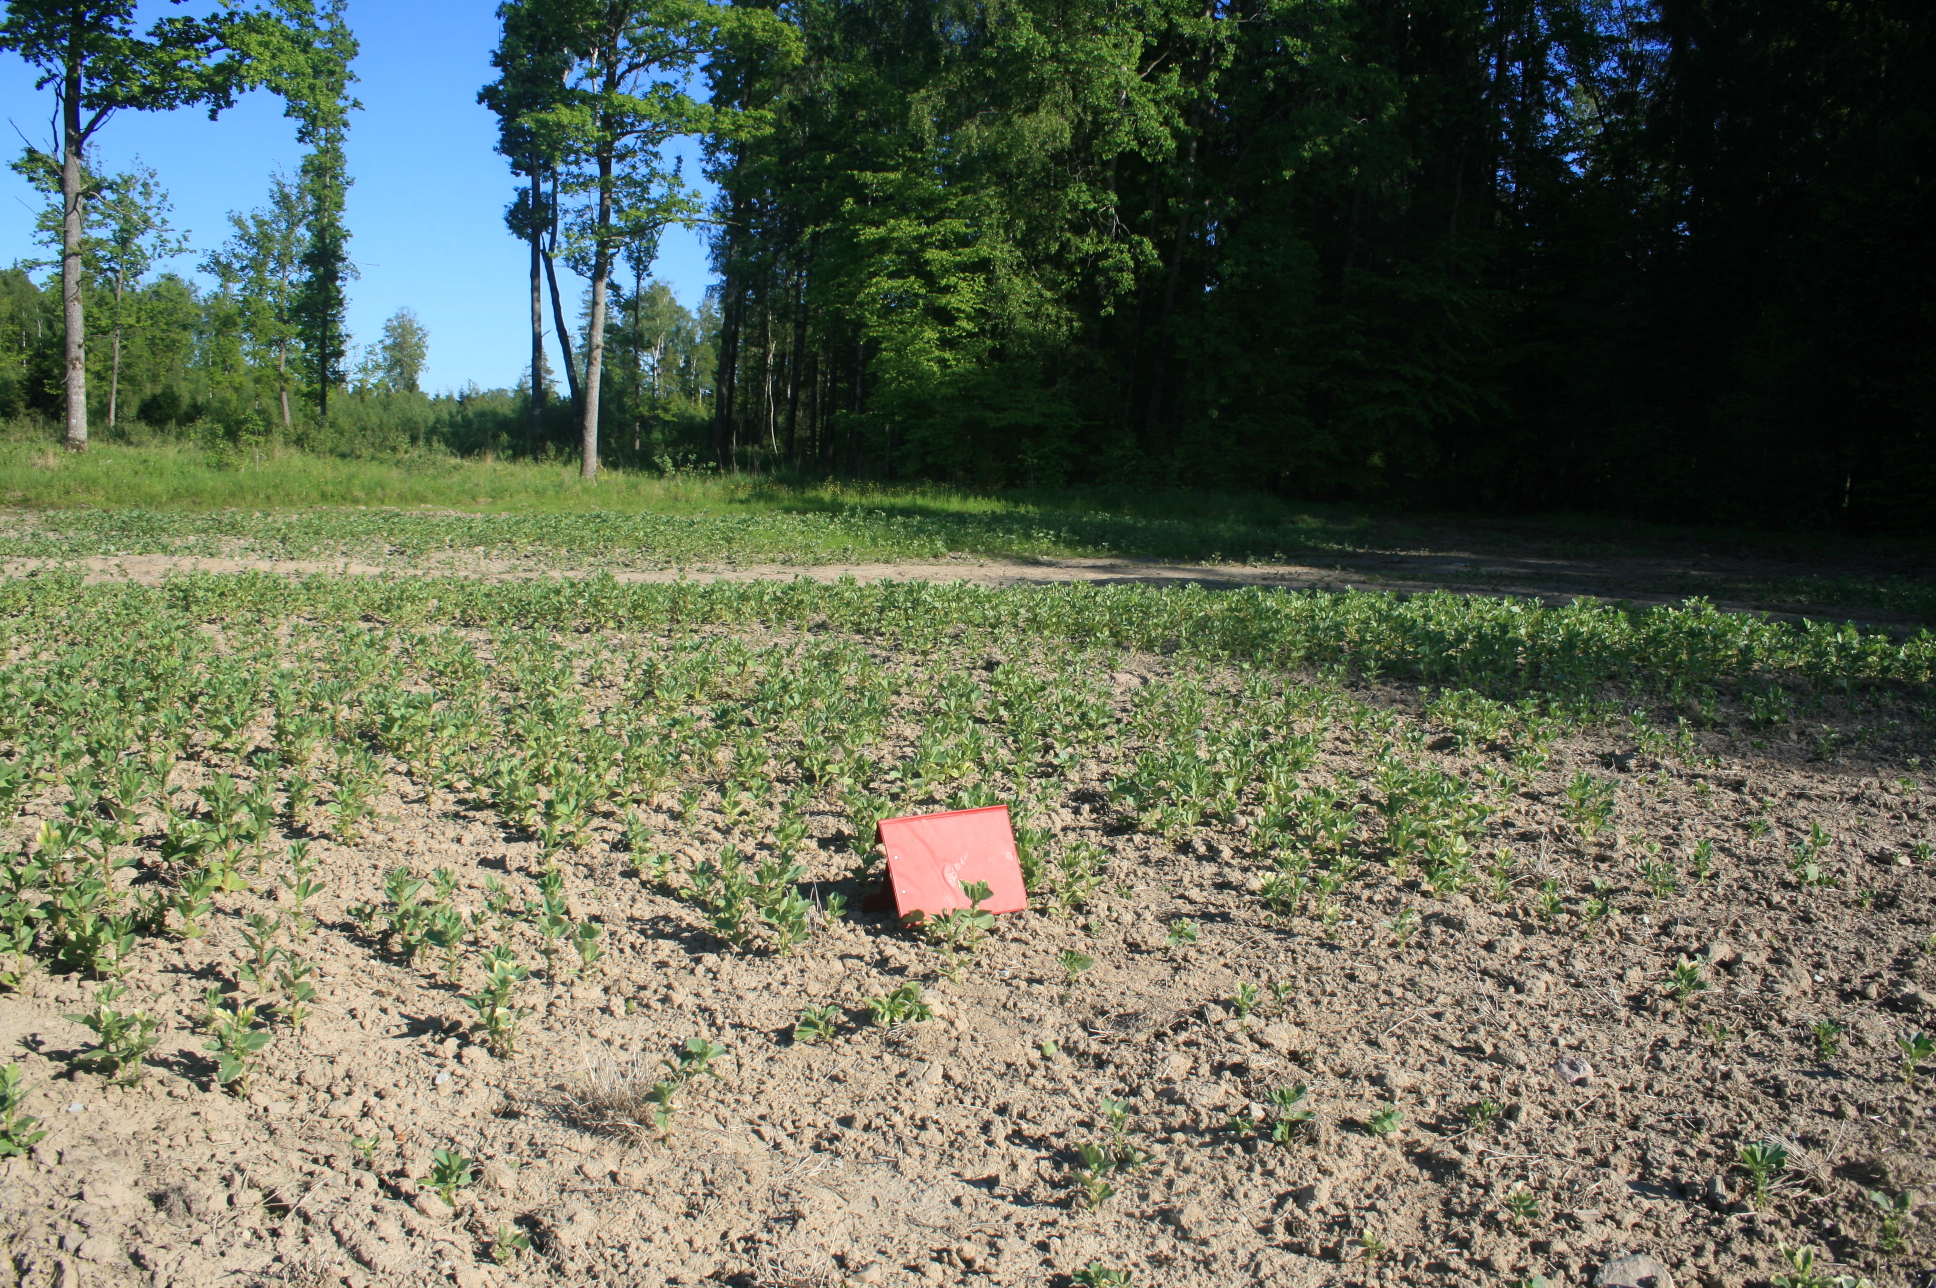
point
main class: Cropland
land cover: Dry pulses
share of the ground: 50 - 75 %
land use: Agriculture (excluding fallow land and kitchen gardens)
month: June
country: LT
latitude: 55.9508
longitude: 21.3971
